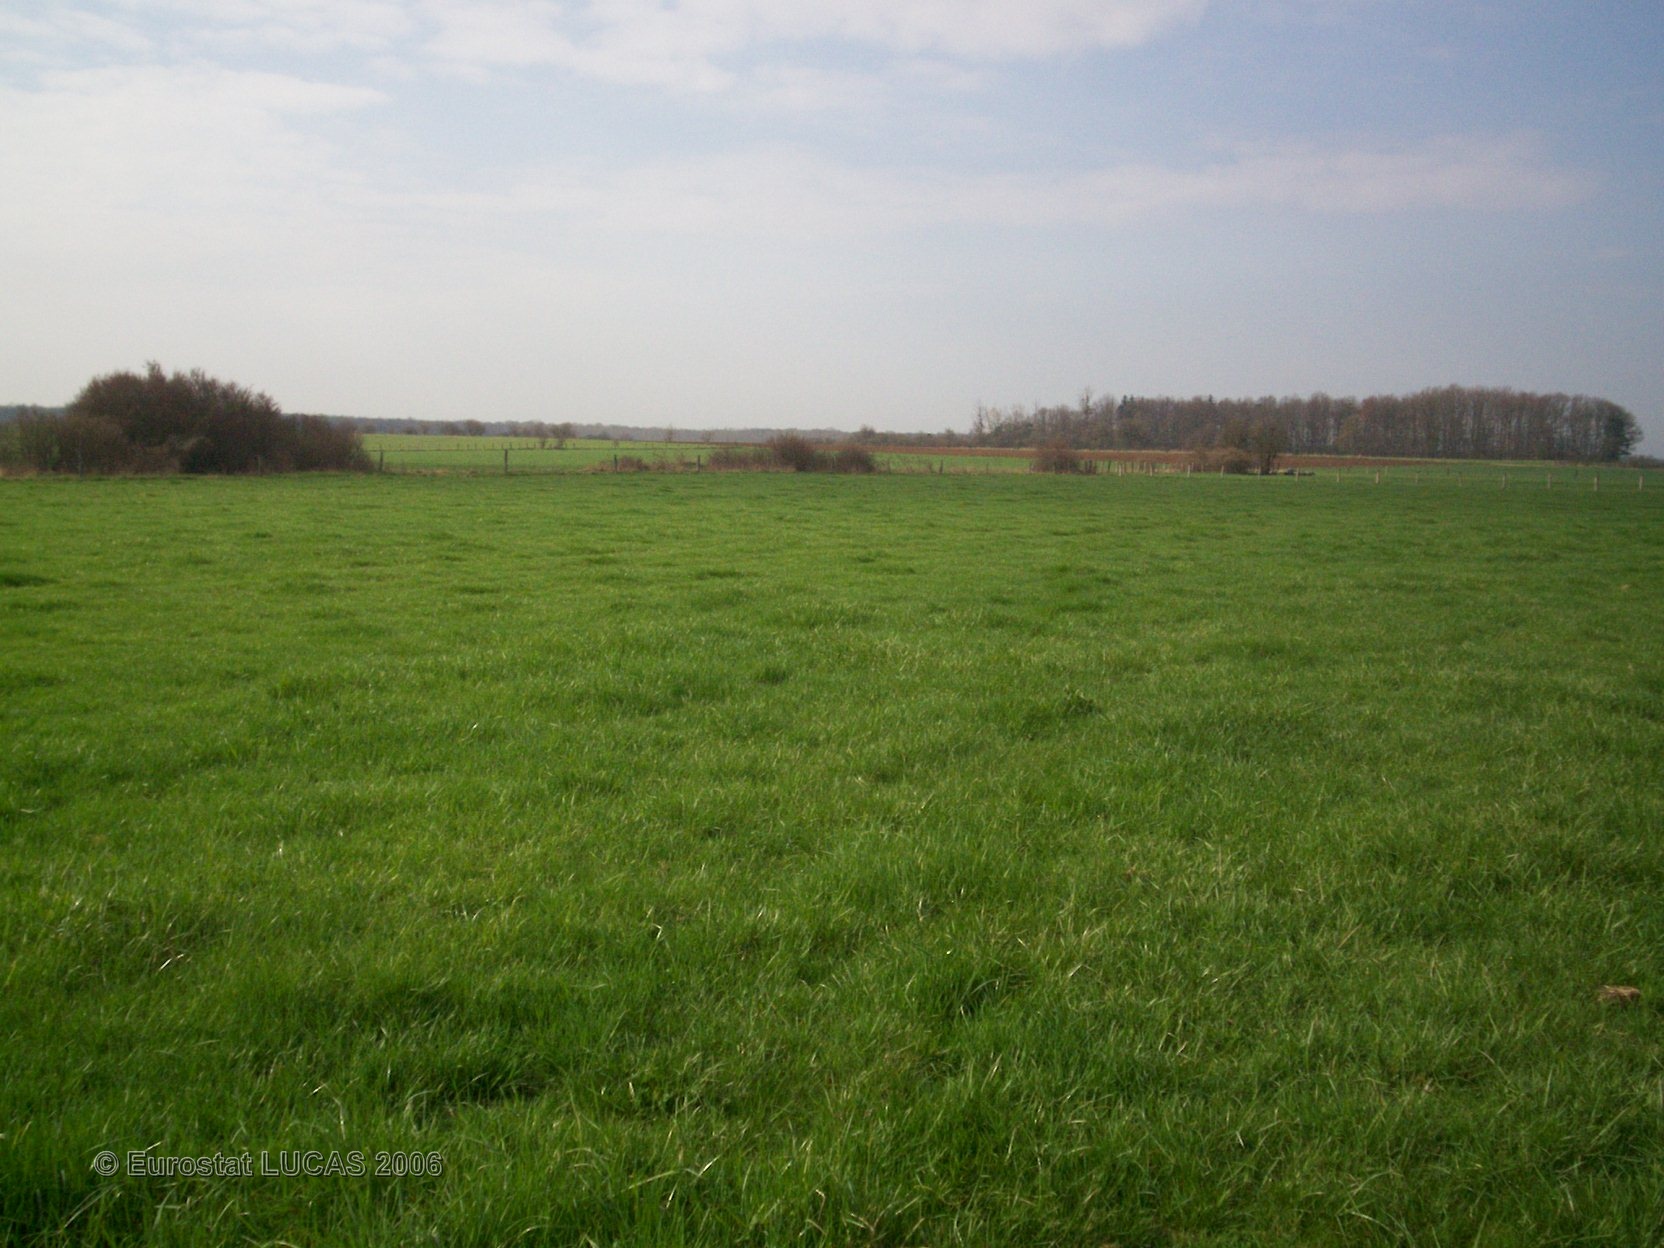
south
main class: Grassland
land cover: Grassland without tree/shrub cover
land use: Agriculture (excluding fallow land and kitchen gardens)
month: April
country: FR
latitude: 48.8139
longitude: 5.9005
